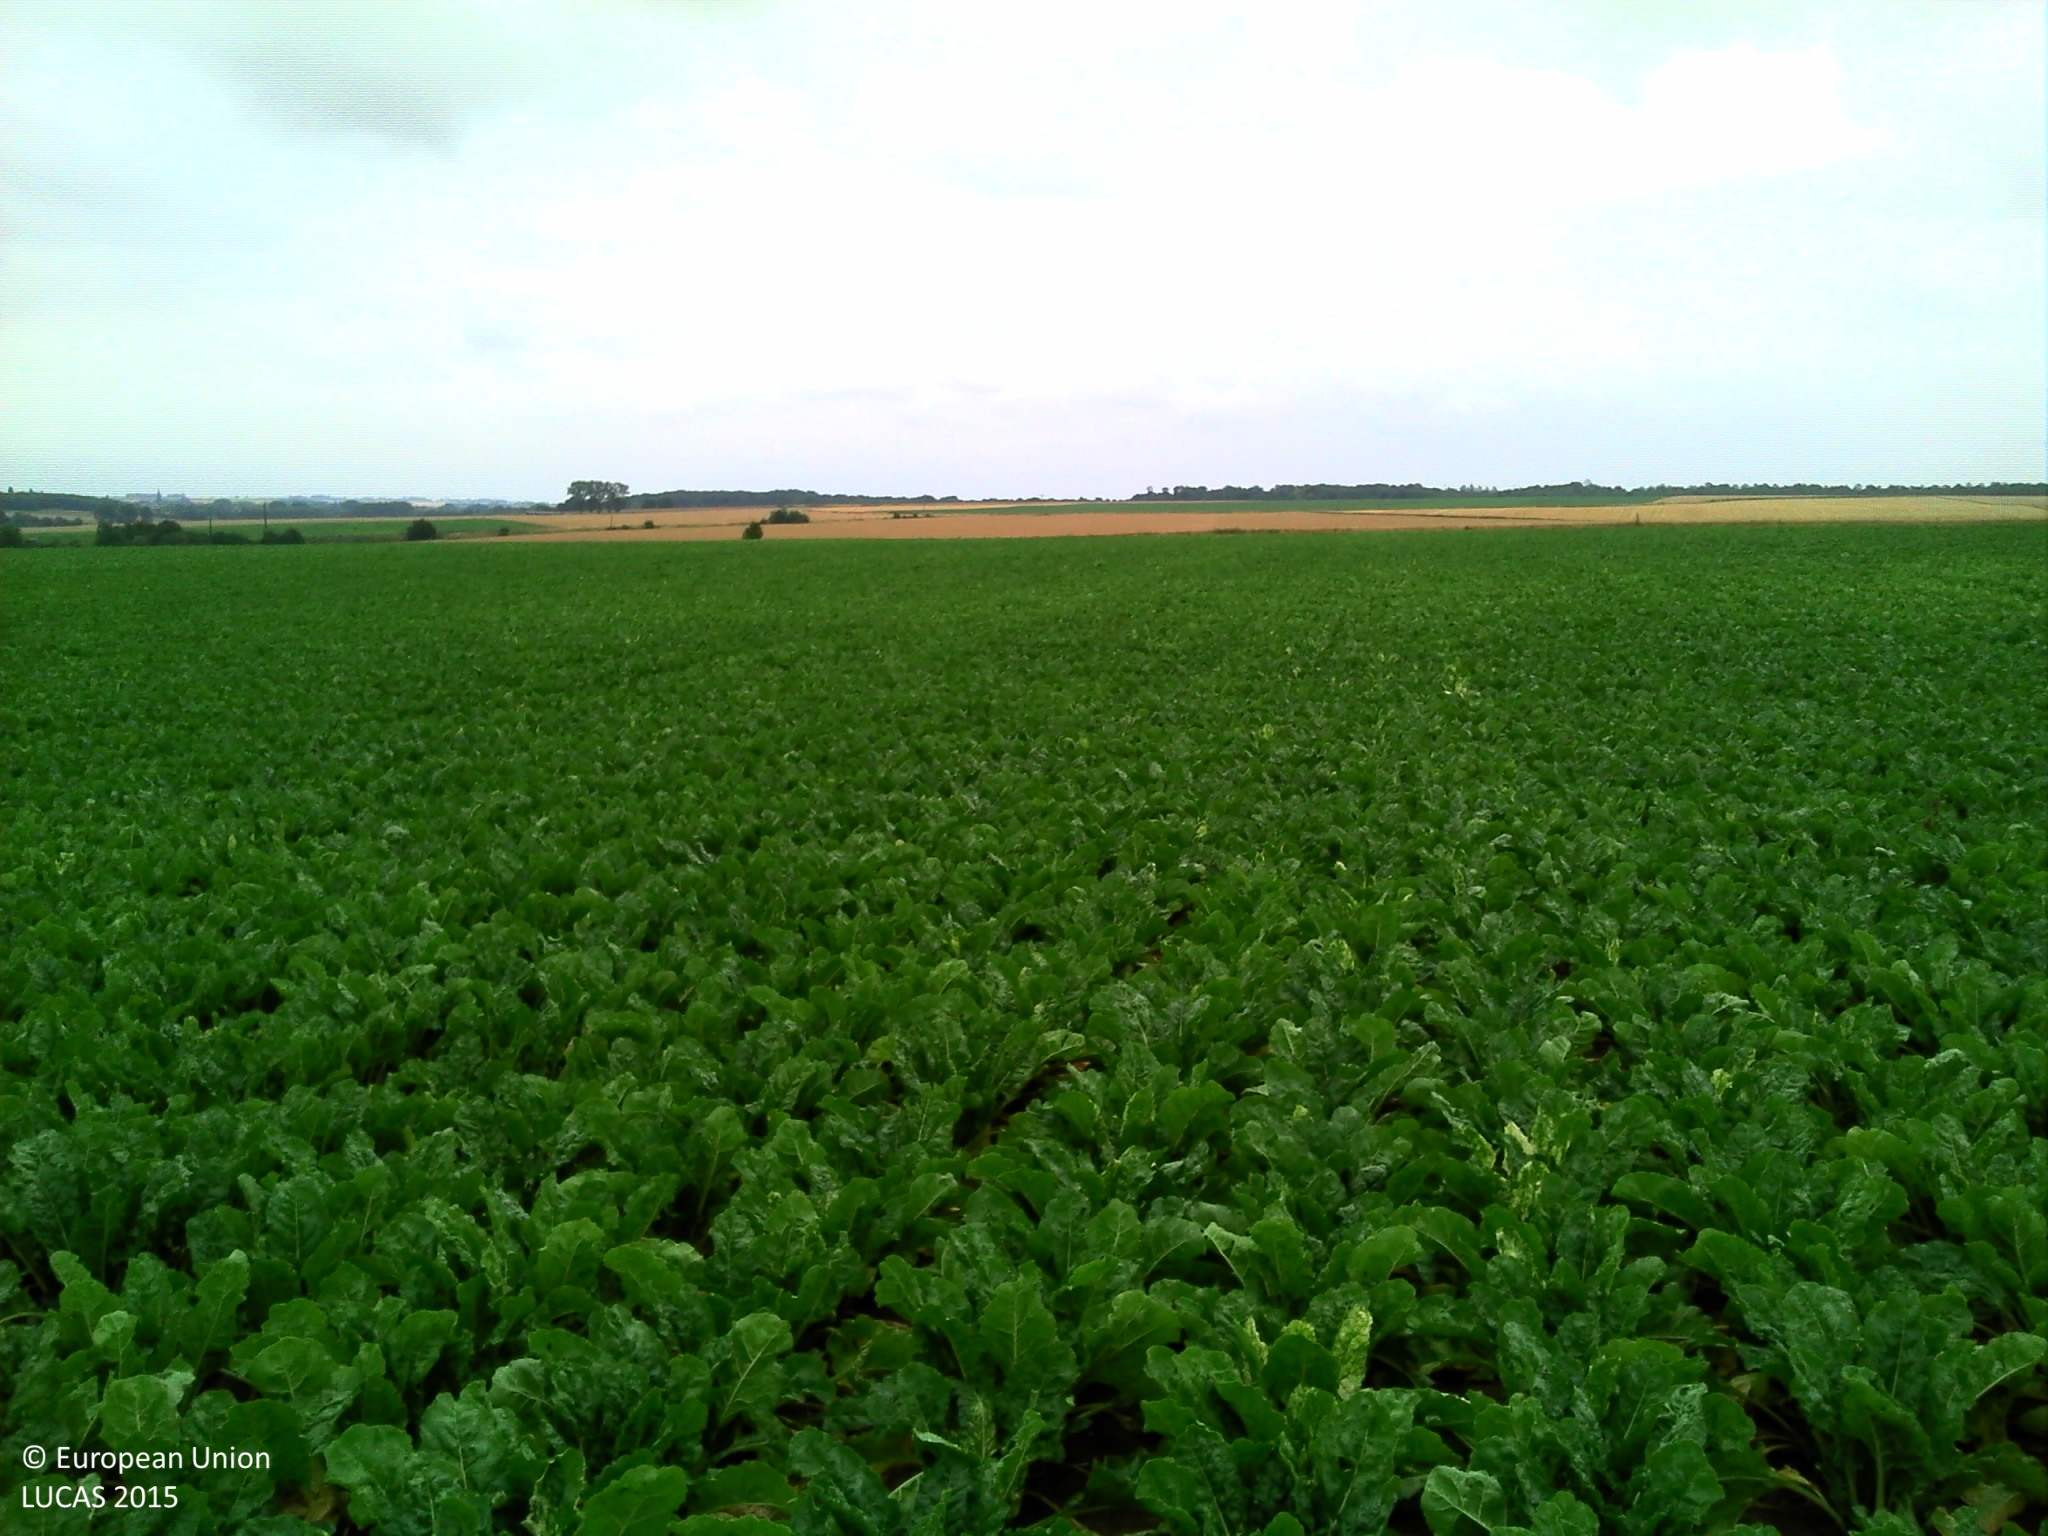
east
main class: Cropland
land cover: Sugar beet
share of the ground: > 75 %
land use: Agriculture (excluding fallow land and kitchen gardens)
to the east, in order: Sugar beet; Grass margins; Paved roads, cycling and walking lanes; Grass margins; Common wheat
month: July
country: FR
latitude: 50.1031
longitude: 3.1260
